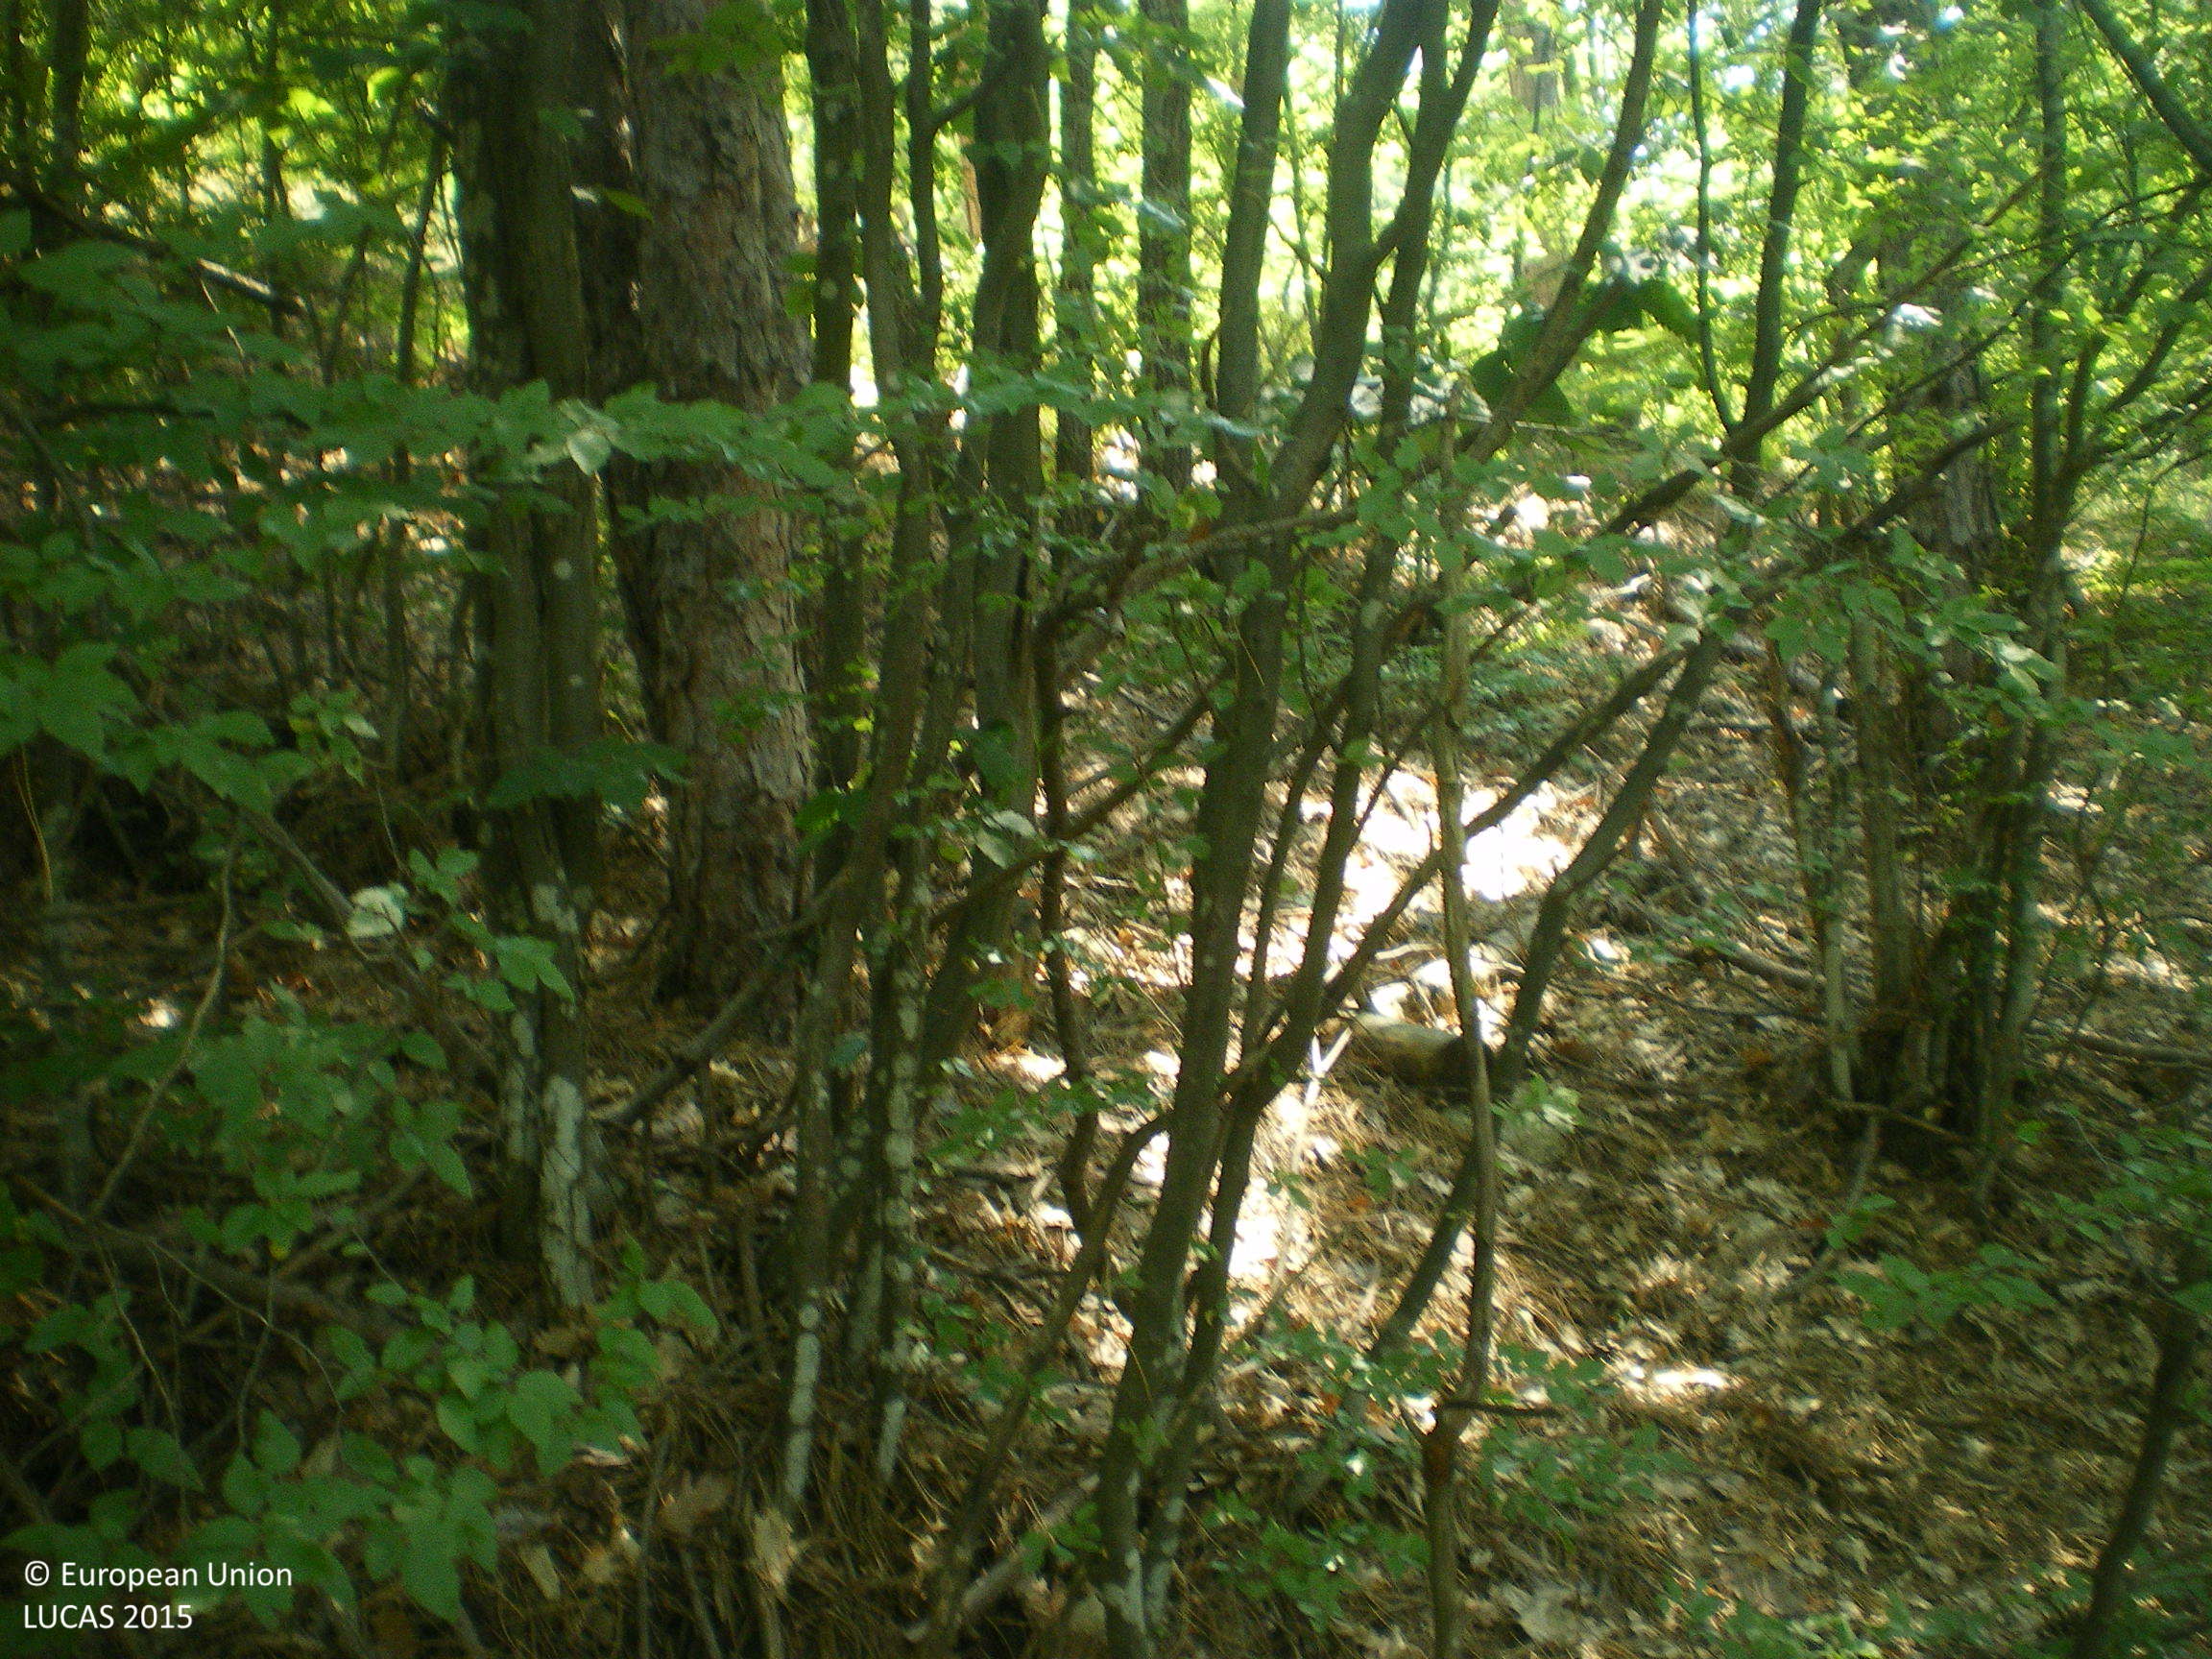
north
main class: Woodland
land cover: Pine dominated coniferous woodland
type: coniferous forest of the mediterranean region
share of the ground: > 75 %
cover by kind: coniferous forest trees 75 %, broadleaved forest trees 25 %
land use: Forestry
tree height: > 5 m
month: July
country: BG
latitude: 42.6757
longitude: 25.0606
